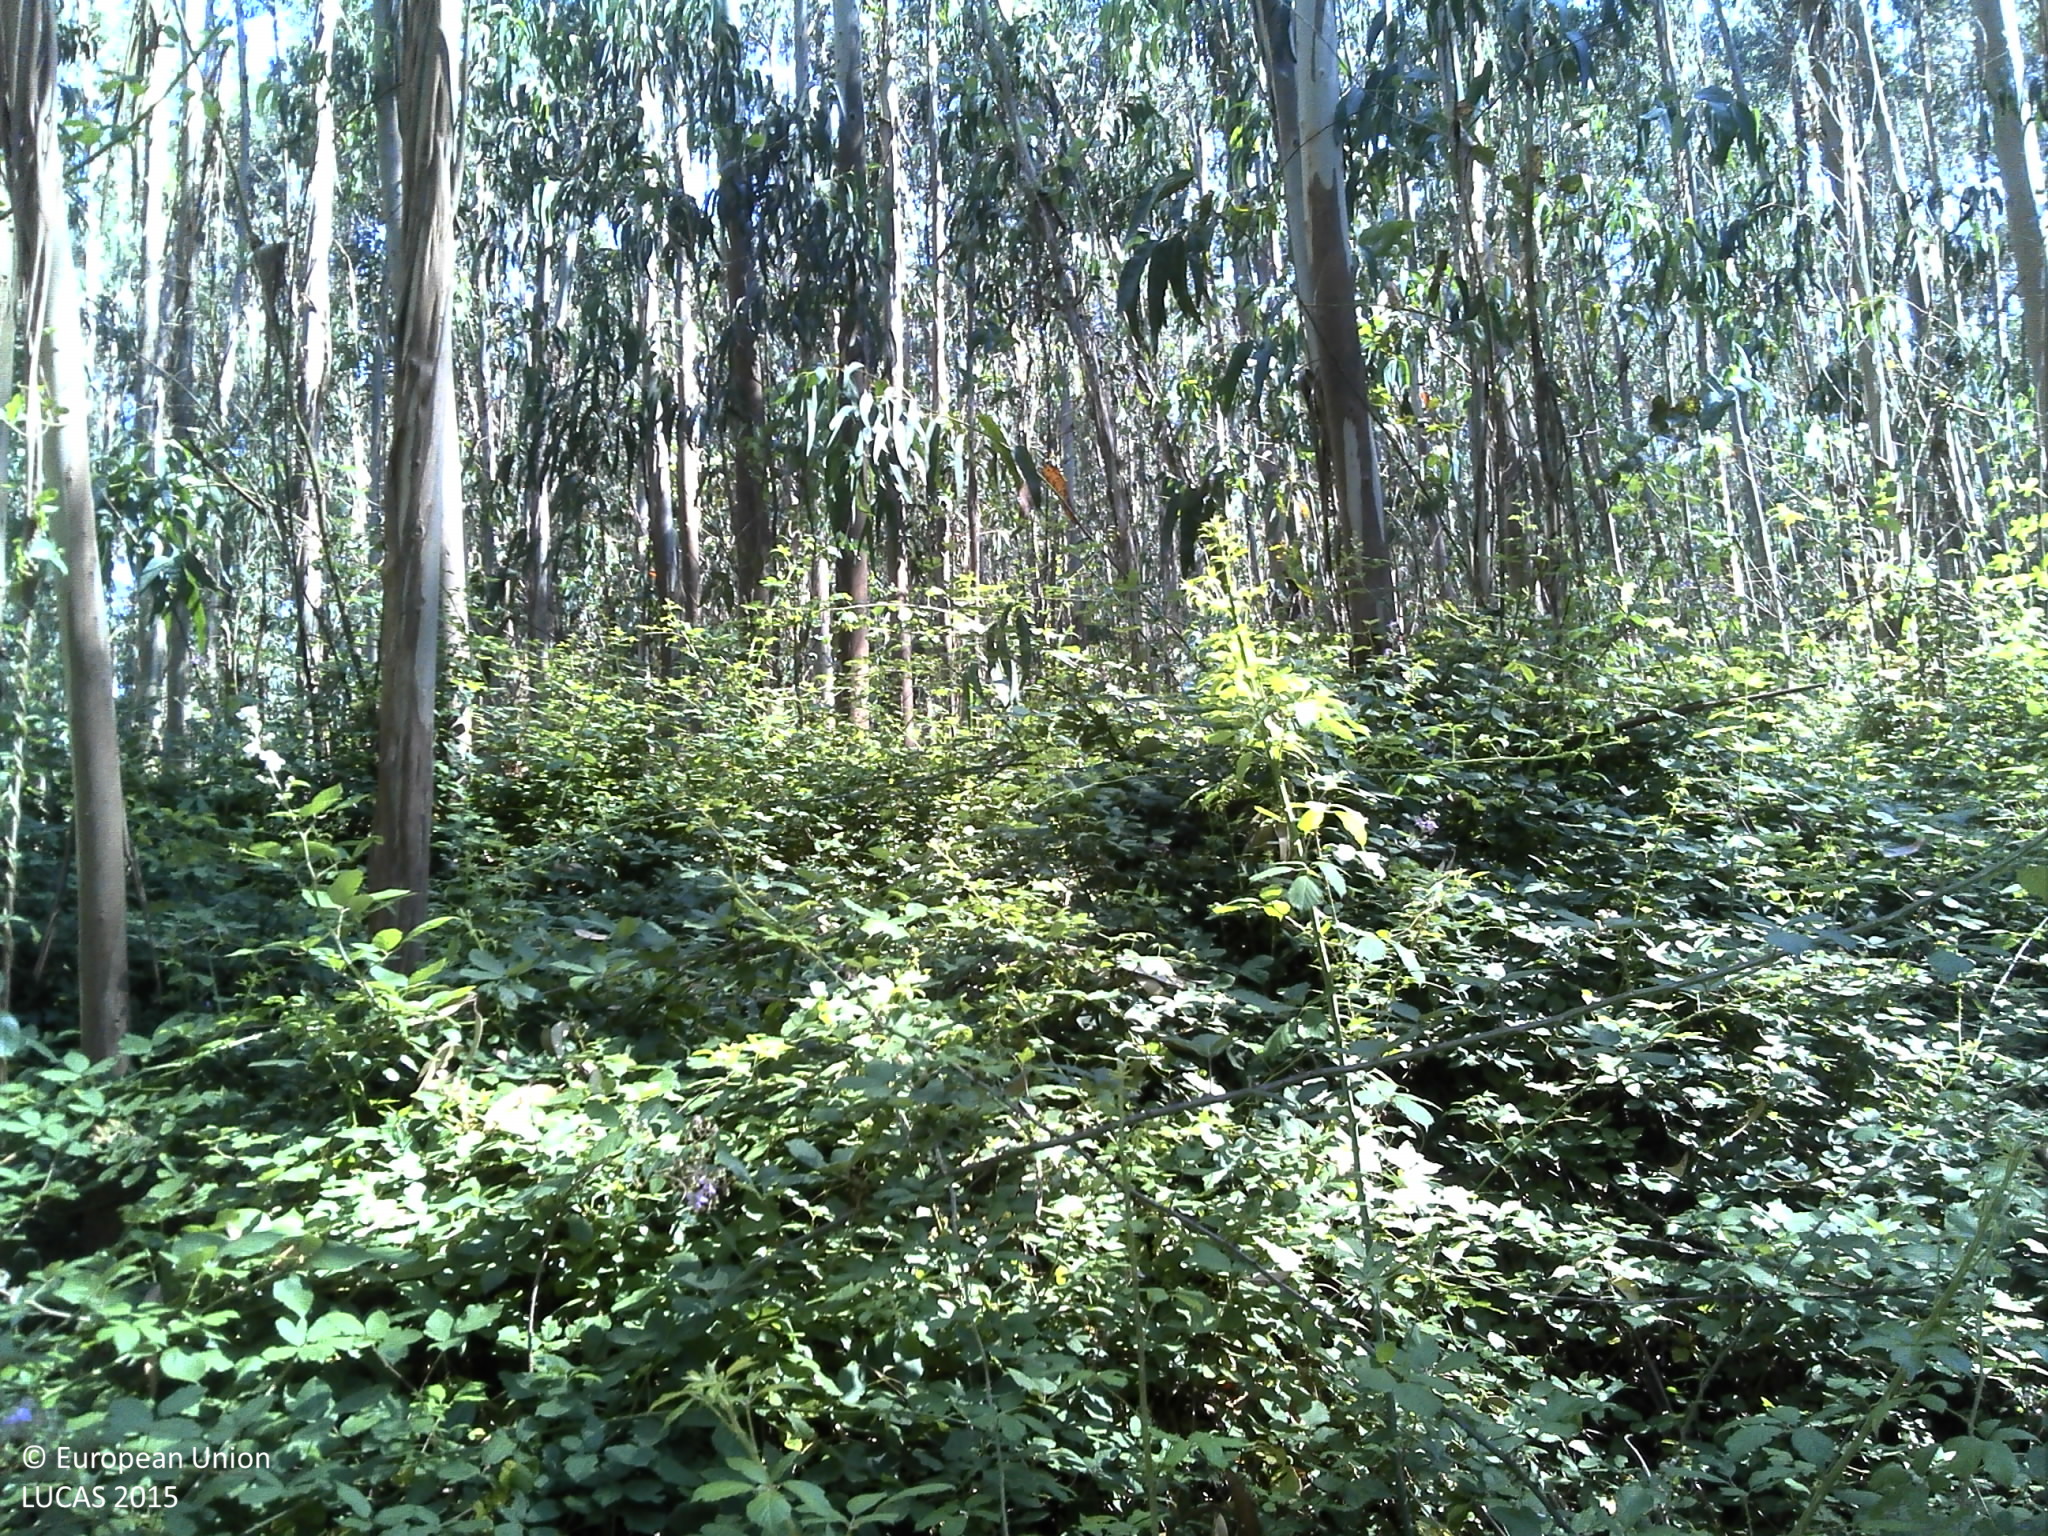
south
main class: Woodland
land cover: Broadleaved woodland
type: exotic forest
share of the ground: > 75 %
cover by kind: broadleaved forest trees 80 %, shrubs 10 %, unconsolidated bare surface 10 %
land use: Forestry
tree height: > 5 m
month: June
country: PT
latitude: 39.2107
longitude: -9.2553
